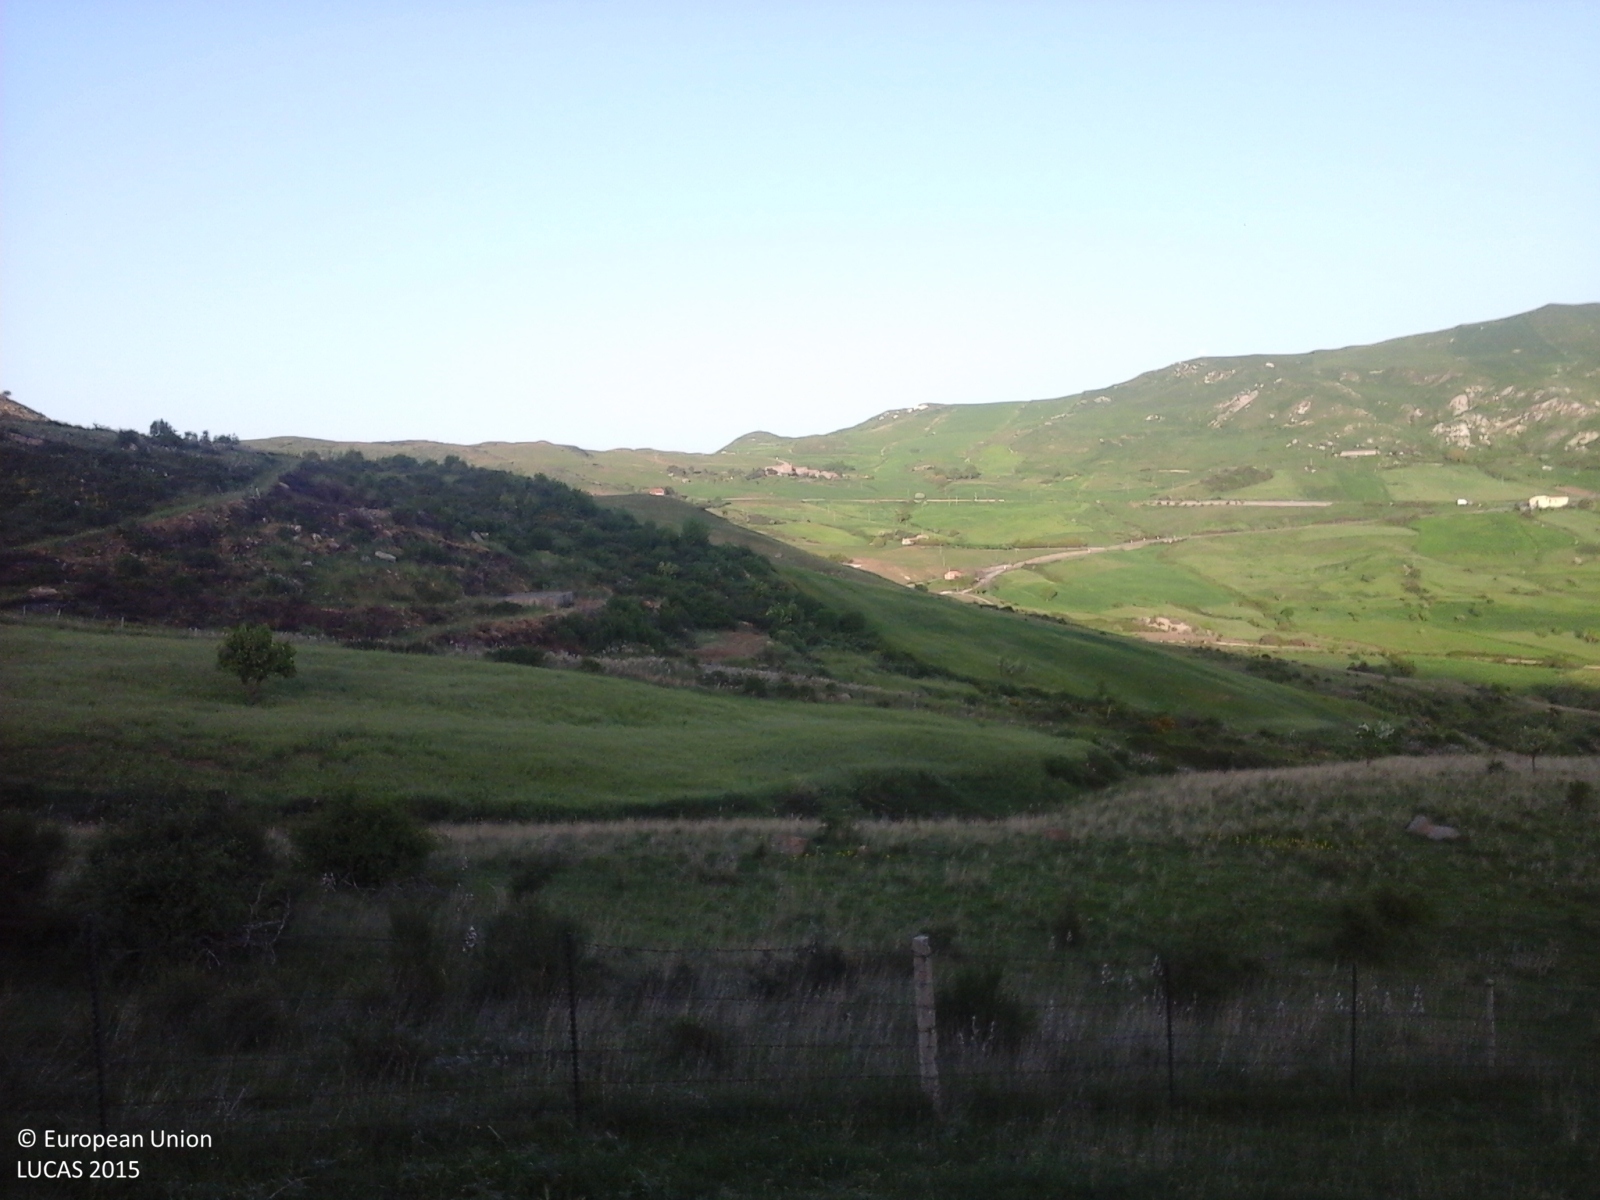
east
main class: Cropland
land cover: Pear fruit
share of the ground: 25 - 50 %
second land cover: Spontaneously vegetated surfaces
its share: > 75 %
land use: Agriculture (excluding fallow land and kitchen gardens)
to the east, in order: Pear fruit; Spontaneously vegetated surfaces; Fences; Grassland with sparse tree/shrub cover; Fences; Shrubland without tree cover; Grassland without tree/shrub cover; Shruby margins; Rivers and streams; Shruby margins; Grass margins; Oats; Grass margins; Fences; Grass margins; Tracks; Grassland with sparse tree/shrub cover; Shrubland with sparse tree cover
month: May
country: IT
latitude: 37.8210
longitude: 14.1398
